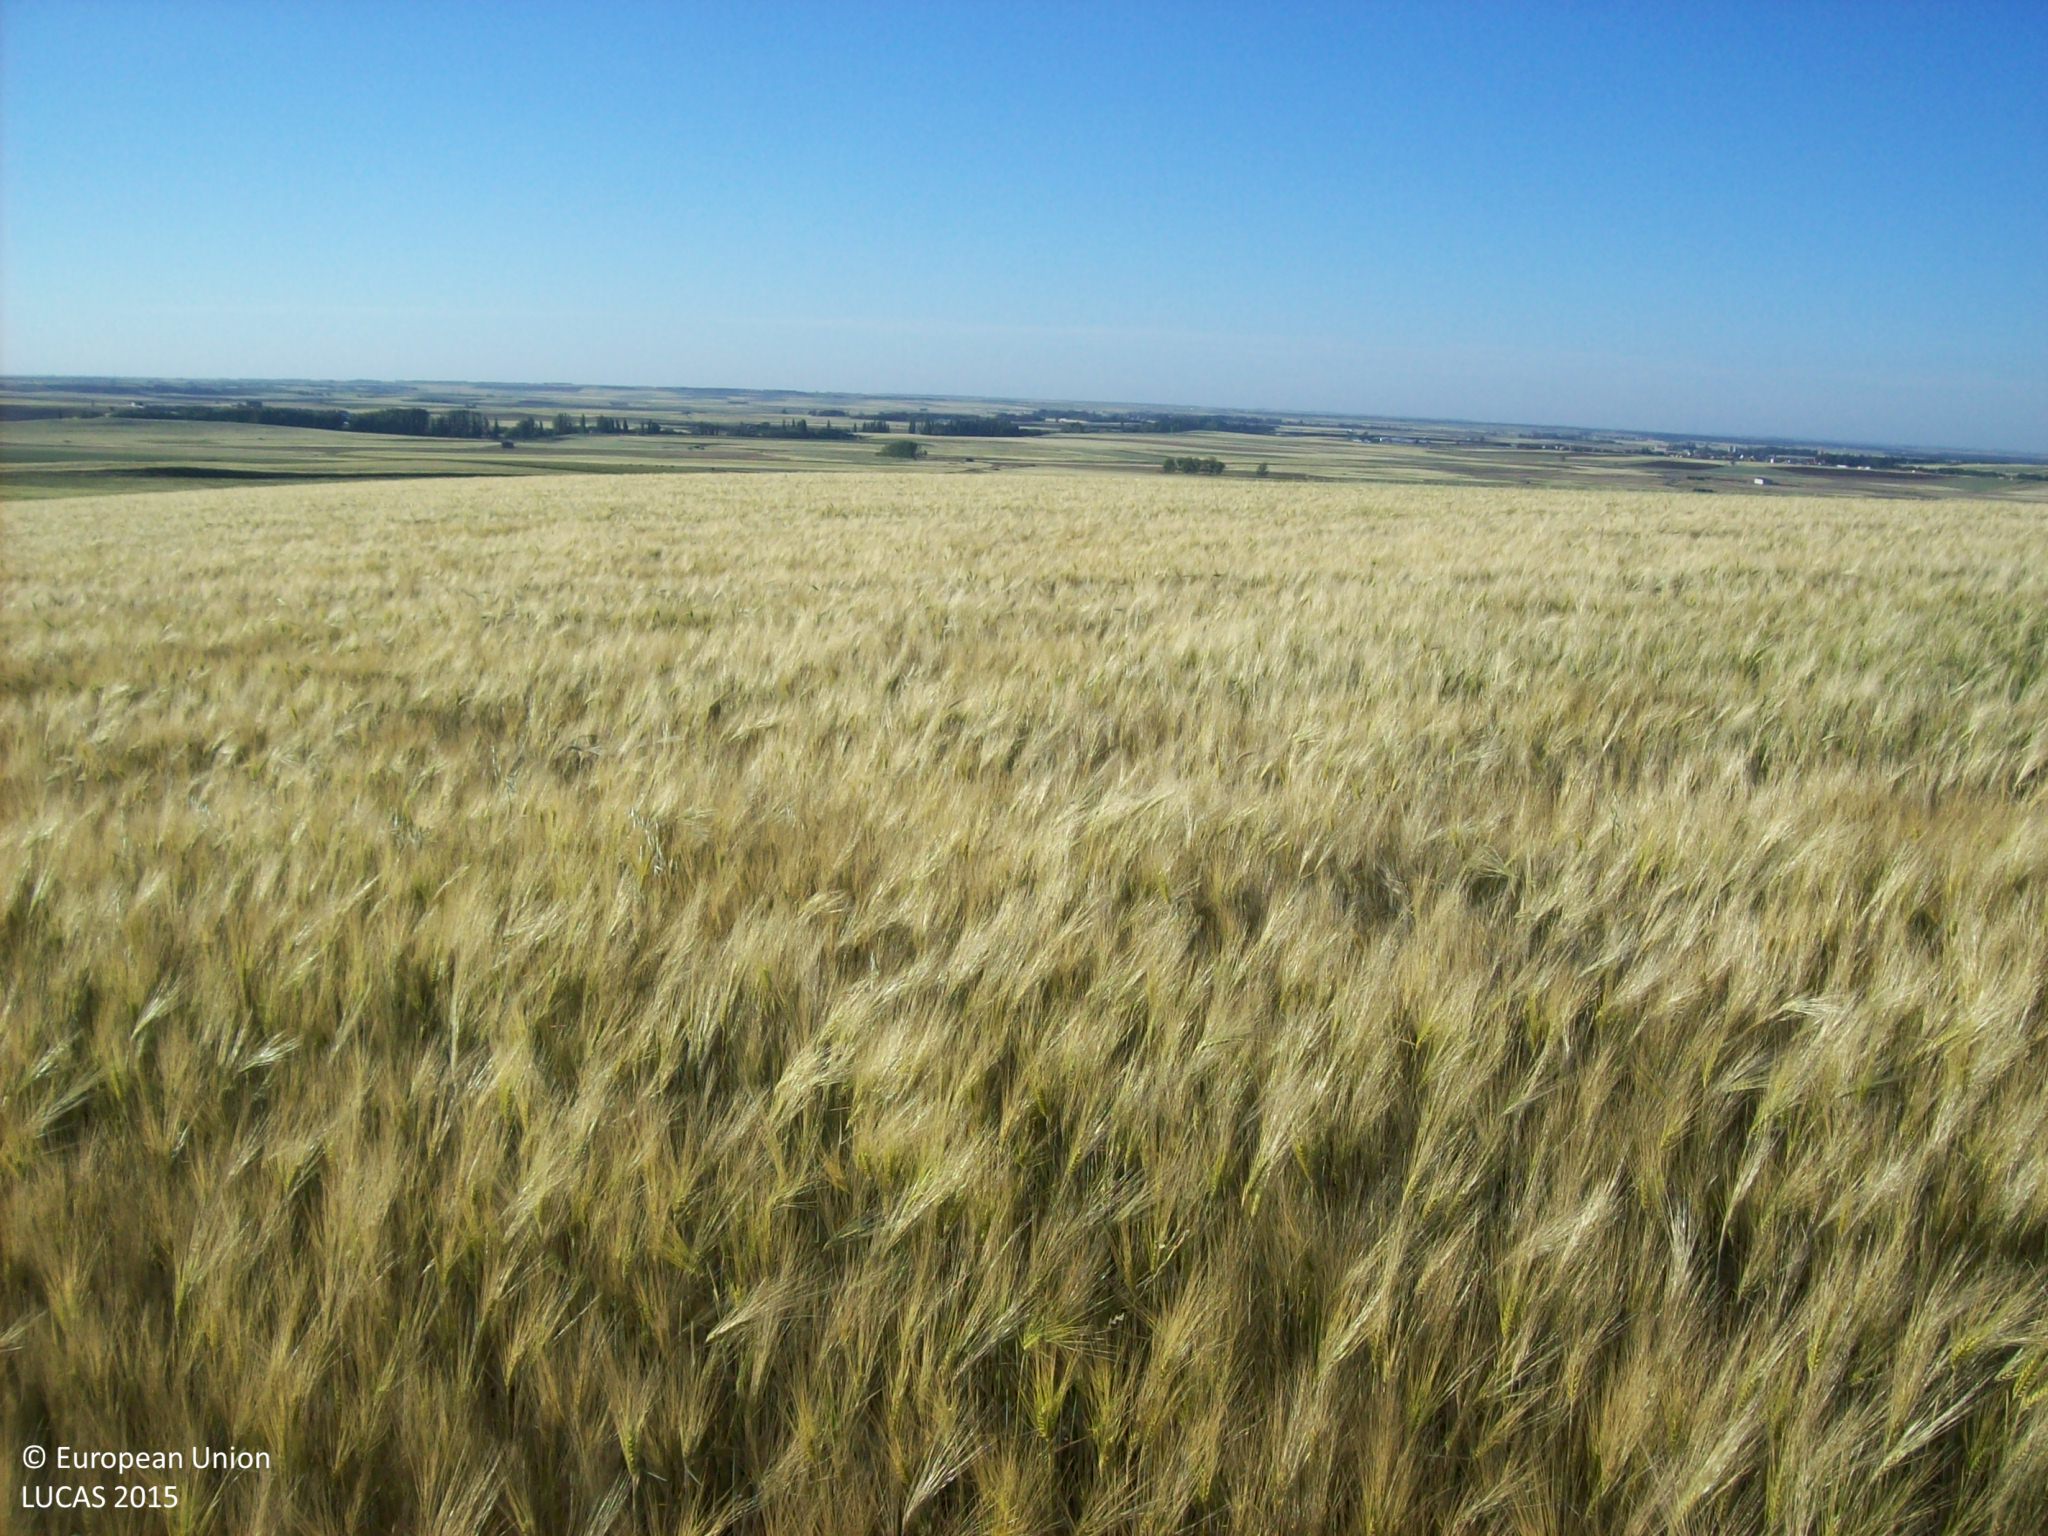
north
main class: Cropland
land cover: Barley
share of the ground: > 75 %
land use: Agriculture (excluding fallow land and kitchen gardens)
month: May
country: ES
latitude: 40.7559
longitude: -4.9019
